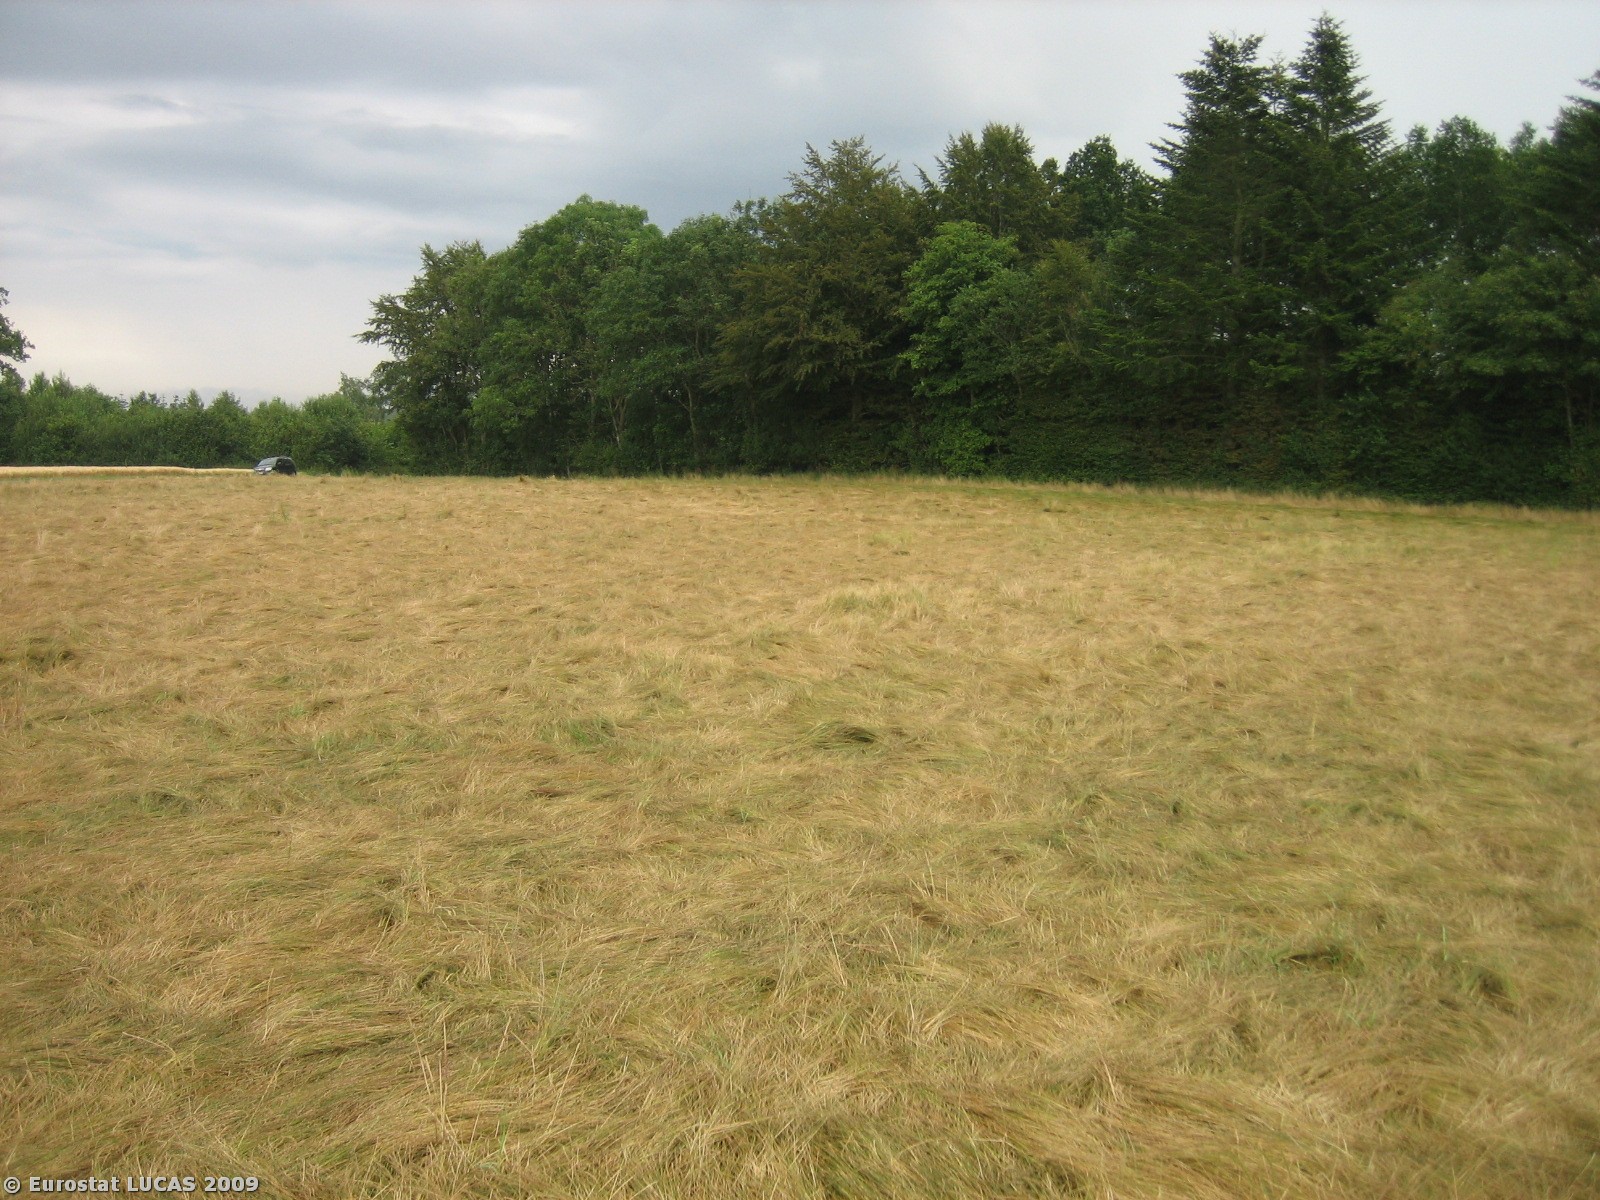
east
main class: Cropland
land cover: Temporary grasslands
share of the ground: > 75 %
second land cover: Barley
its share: < 10 %
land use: Agriculture (excluding fallow land and kitchen gardens)
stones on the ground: < 10 %
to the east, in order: Temporary grasslands; Broadleaved woodland; Tracks; Broadleaved woodland
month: July
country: DK
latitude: 55.3789
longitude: 9.9842
